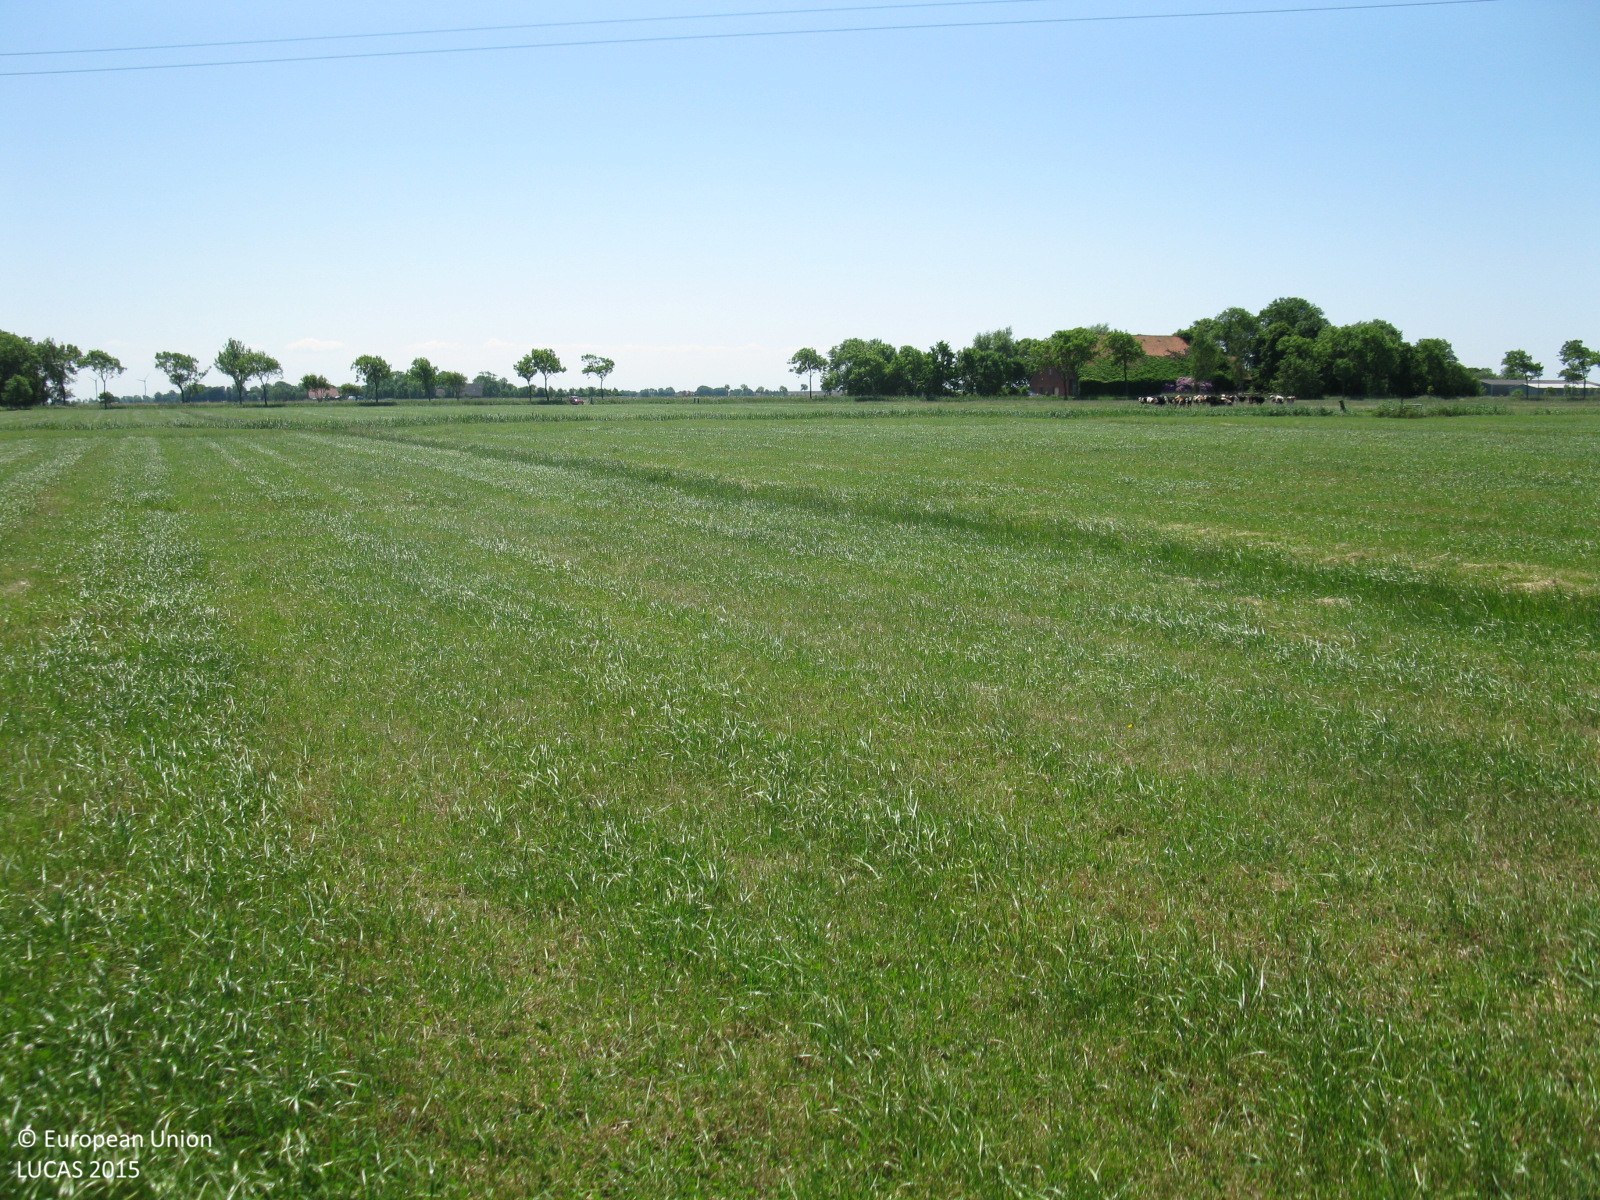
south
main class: Grassland
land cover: Grassland without tree/shrub cover
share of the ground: > 75 %
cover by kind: herbaceous plants 100 %
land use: Agriculture (excluding fallow land and kitchen gardens)
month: June
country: DE
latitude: 53.5521
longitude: 8.3253
